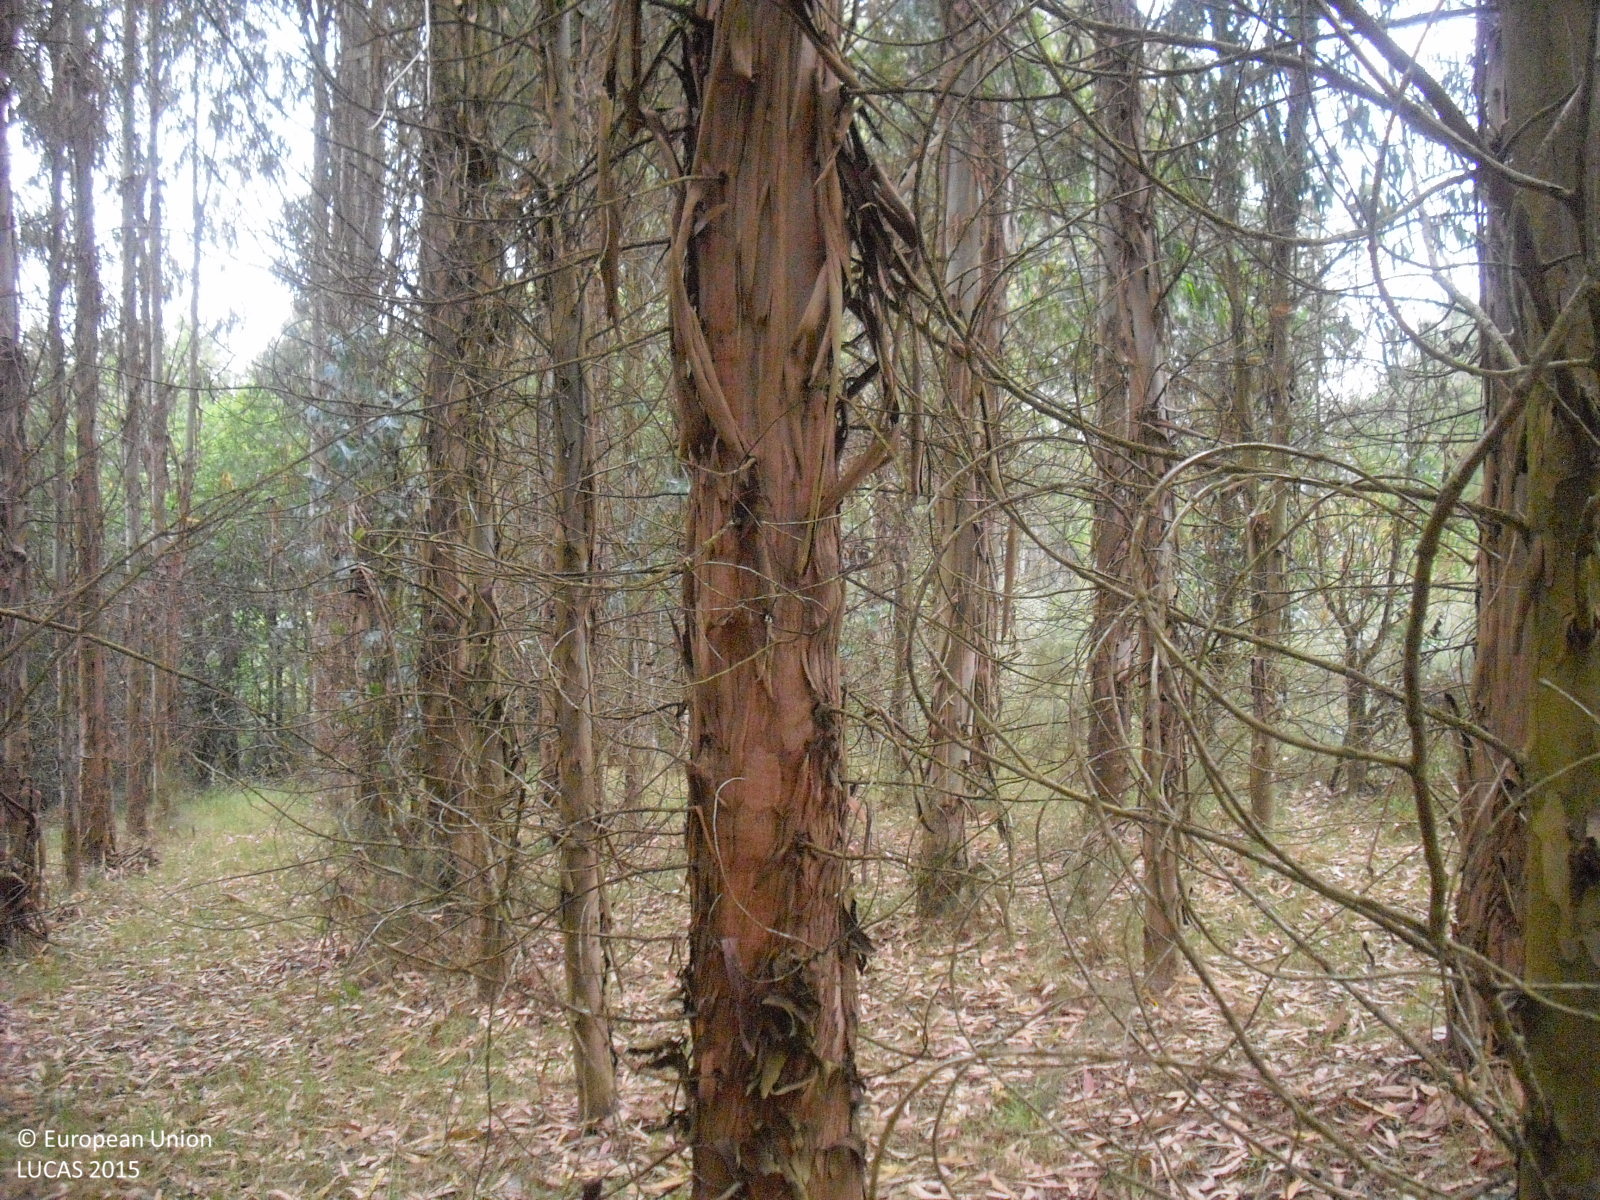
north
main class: Woodland
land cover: Broadleaved woodland
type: exotic forest
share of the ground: > 75 %
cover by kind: broadleaved forest trees 100 %
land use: Forestry
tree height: > 5 m
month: June
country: ES
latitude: 42.7665
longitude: -7.8637
